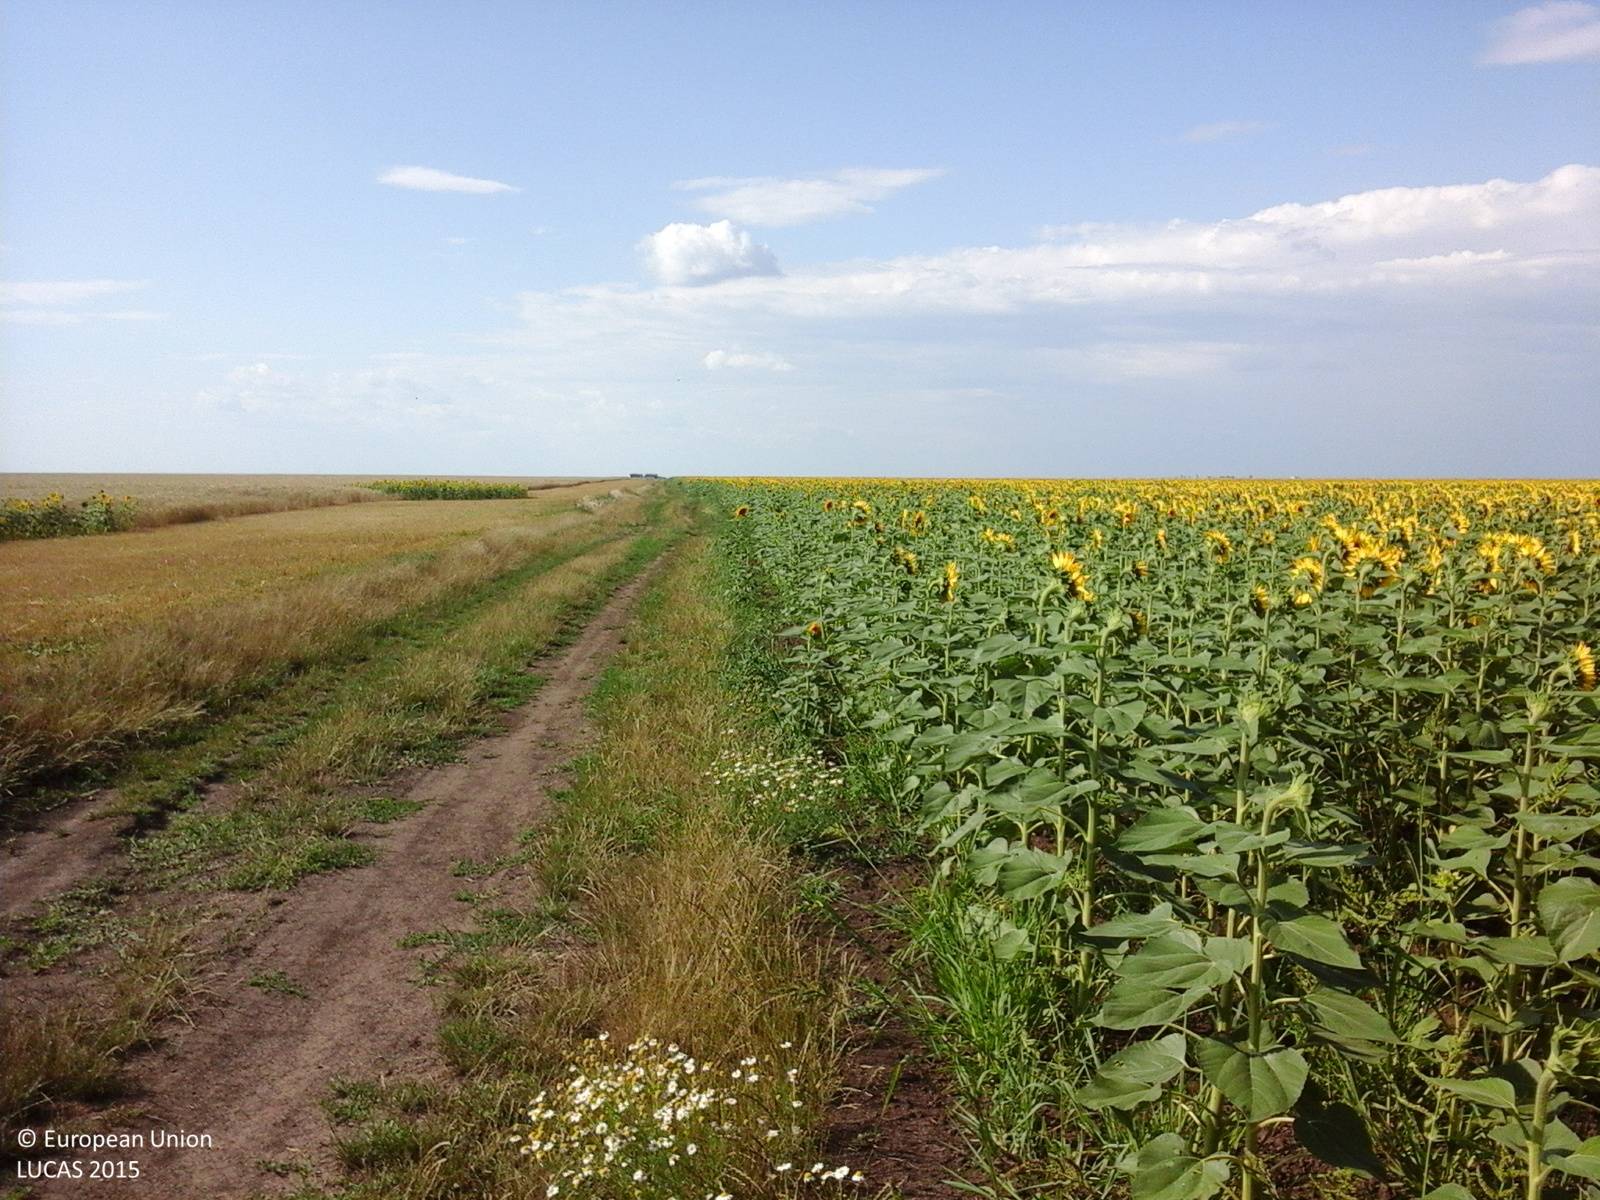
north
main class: Cropland
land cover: Sunflower
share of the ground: > 75 %
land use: Agriculture (excluding fallow land and kitchen gardens)
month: July
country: RO
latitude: 44.0777
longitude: 24.8717
